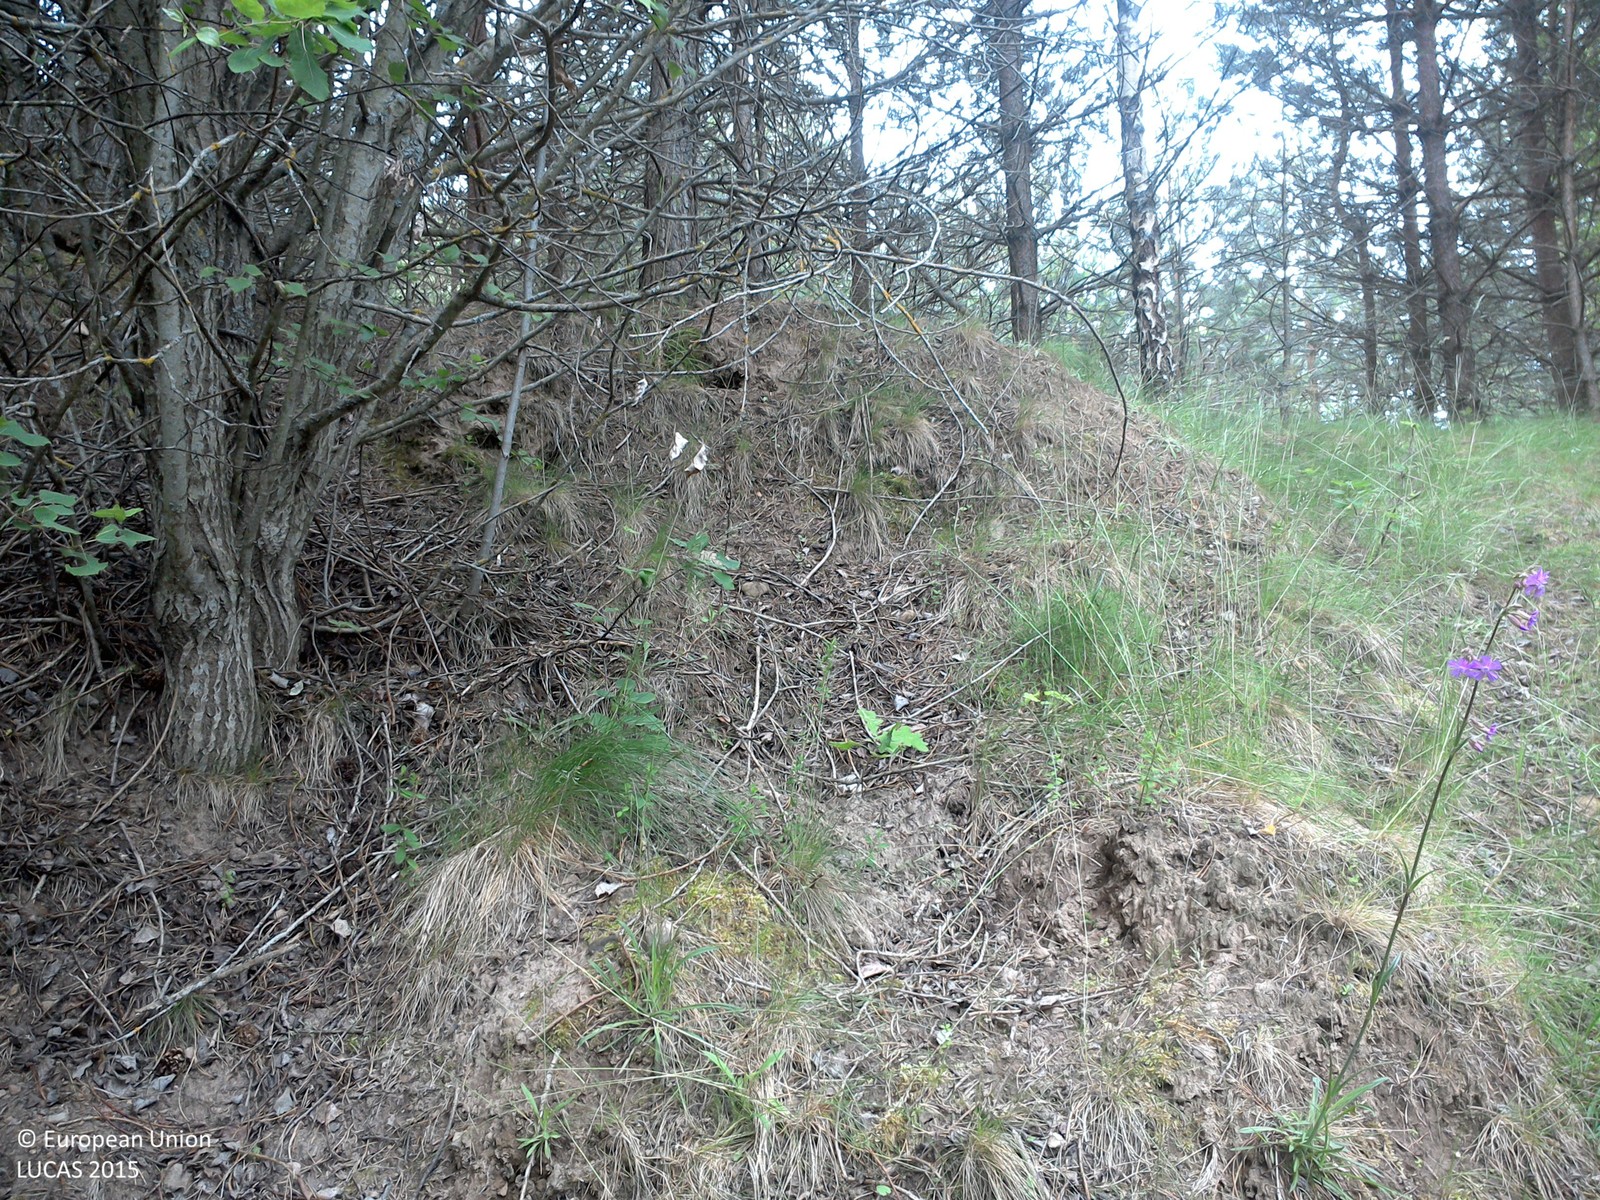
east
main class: Woodland
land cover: Pine dominated coniferous woodland
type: boreal forest
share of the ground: > 75 %
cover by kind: coniferous forest trees 85 %, unconsolidated bare surface 15 %
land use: Forestry
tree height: > 5 m
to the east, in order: Pine dominated coniferous woodland; Fences; Broadleaved woodland; Fences; Grass margins; Oats; Ditches and canals; Grass margins; Paved roads, cycling and walking lanes; Grass margins; Ditches and canals
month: June
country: SE
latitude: 58.3754
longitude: 15.5517
